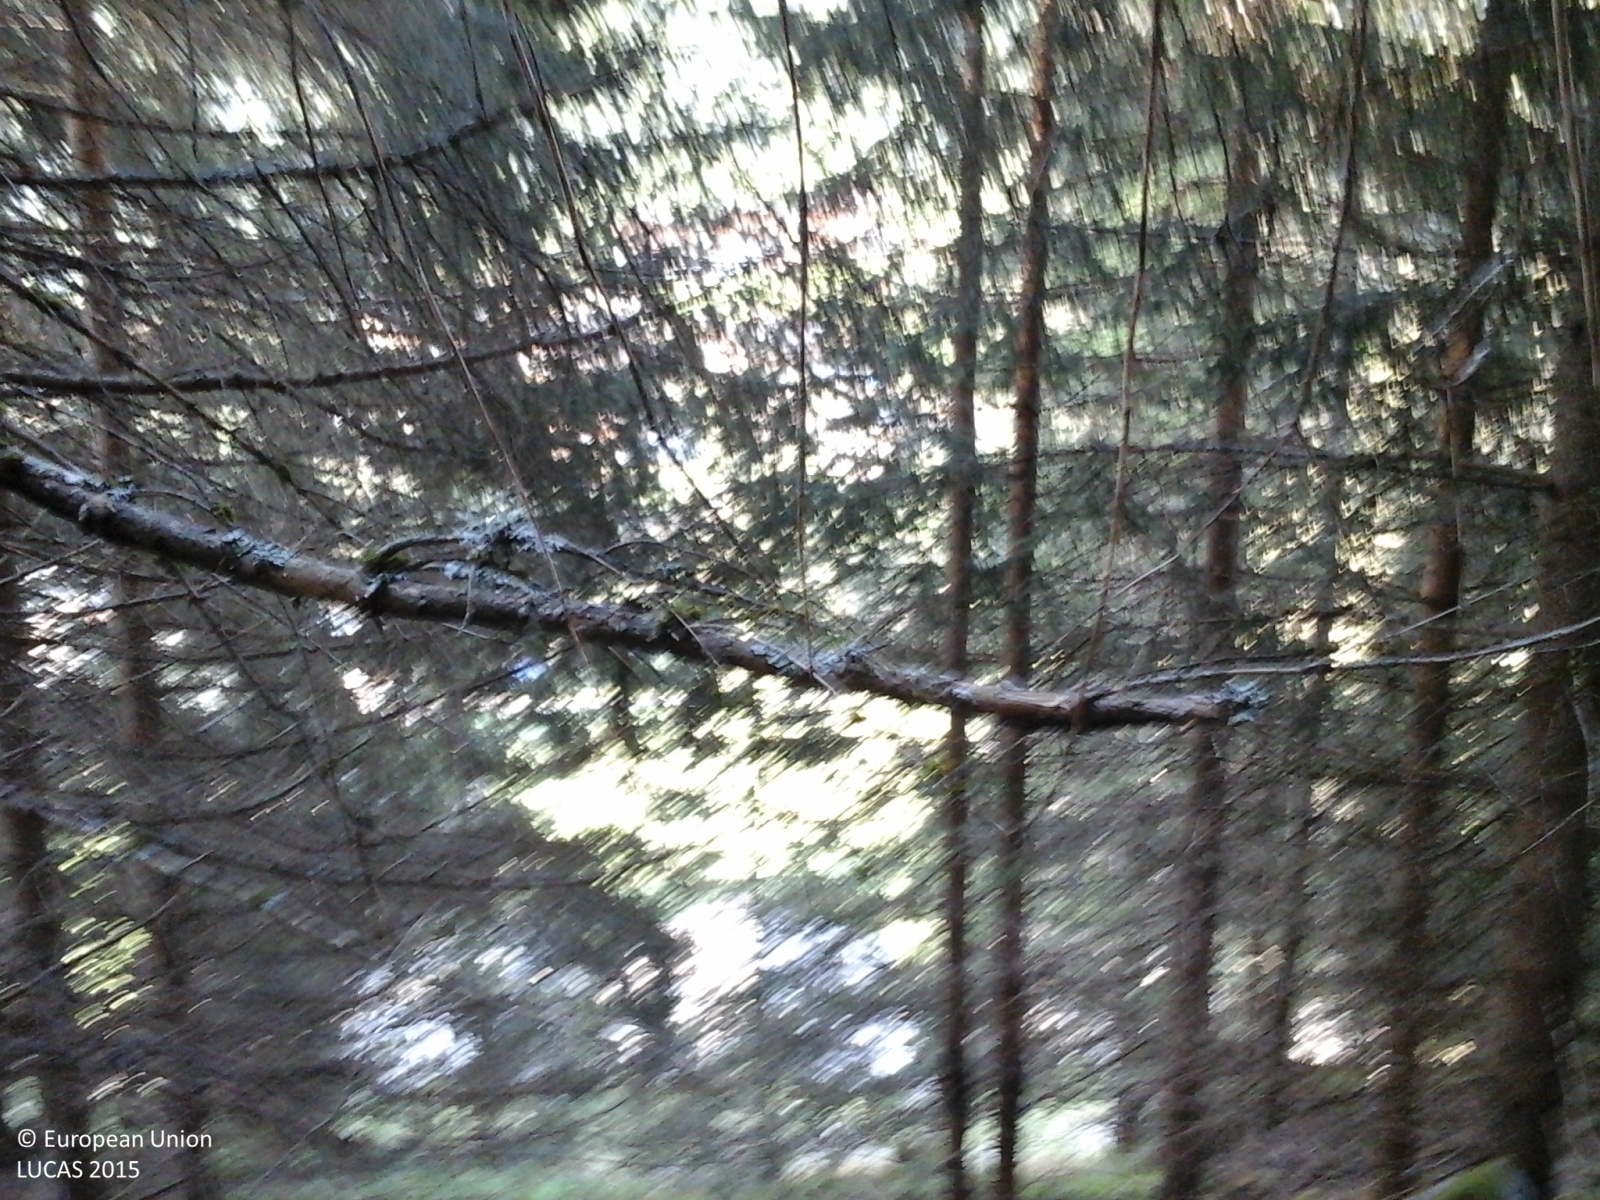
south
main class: Woodland
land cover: Spruce dominated coniferous woodland
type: alpine coniferous forest
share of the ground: > 75 %
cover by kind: coniferous forest trees 100 %
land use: Forestry
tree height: > 5 m
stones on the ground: > 50 %
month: May
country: IT
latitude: 46.4918
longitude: 10.8718
